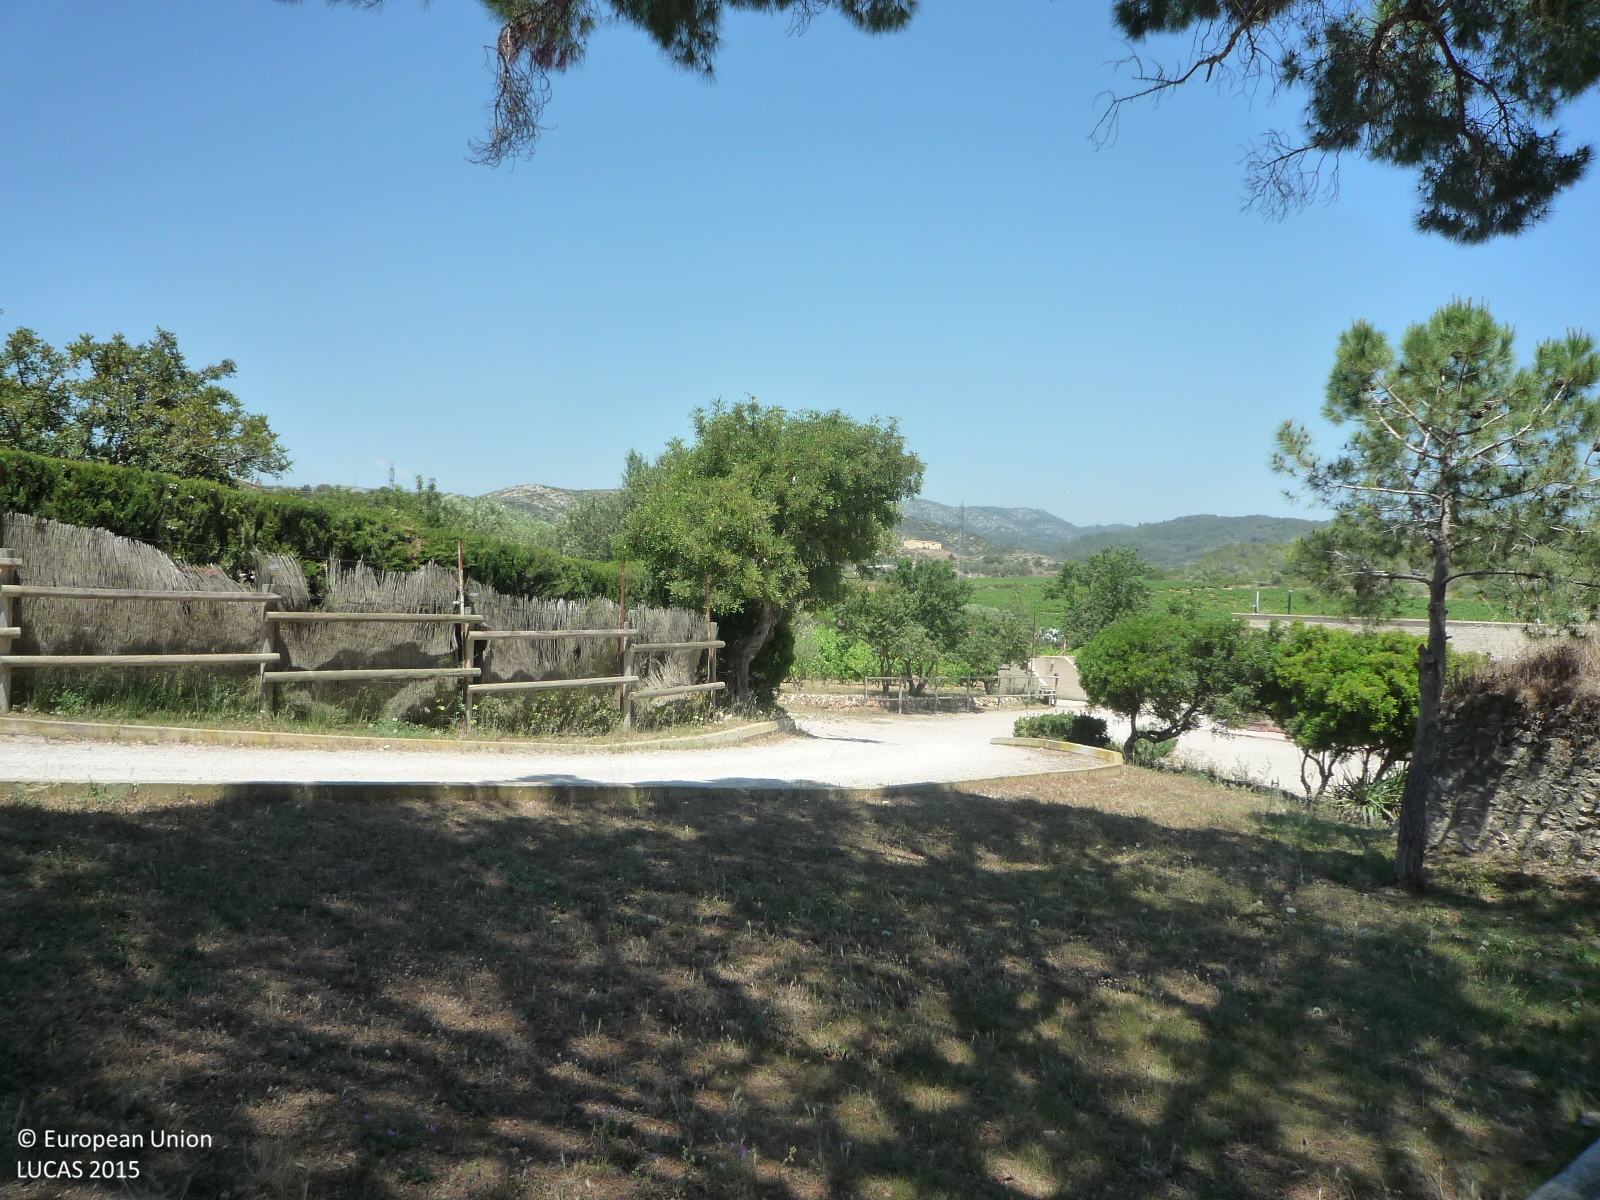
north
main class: Woodland
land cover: Pine dominated coniferous woodland
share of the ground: 25 - 50 %
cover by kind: herbaceous plants 70 %, coniferous forest trees 30 %
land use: Sport
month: May
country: ES
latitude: 41.2419
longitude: 1.7013
